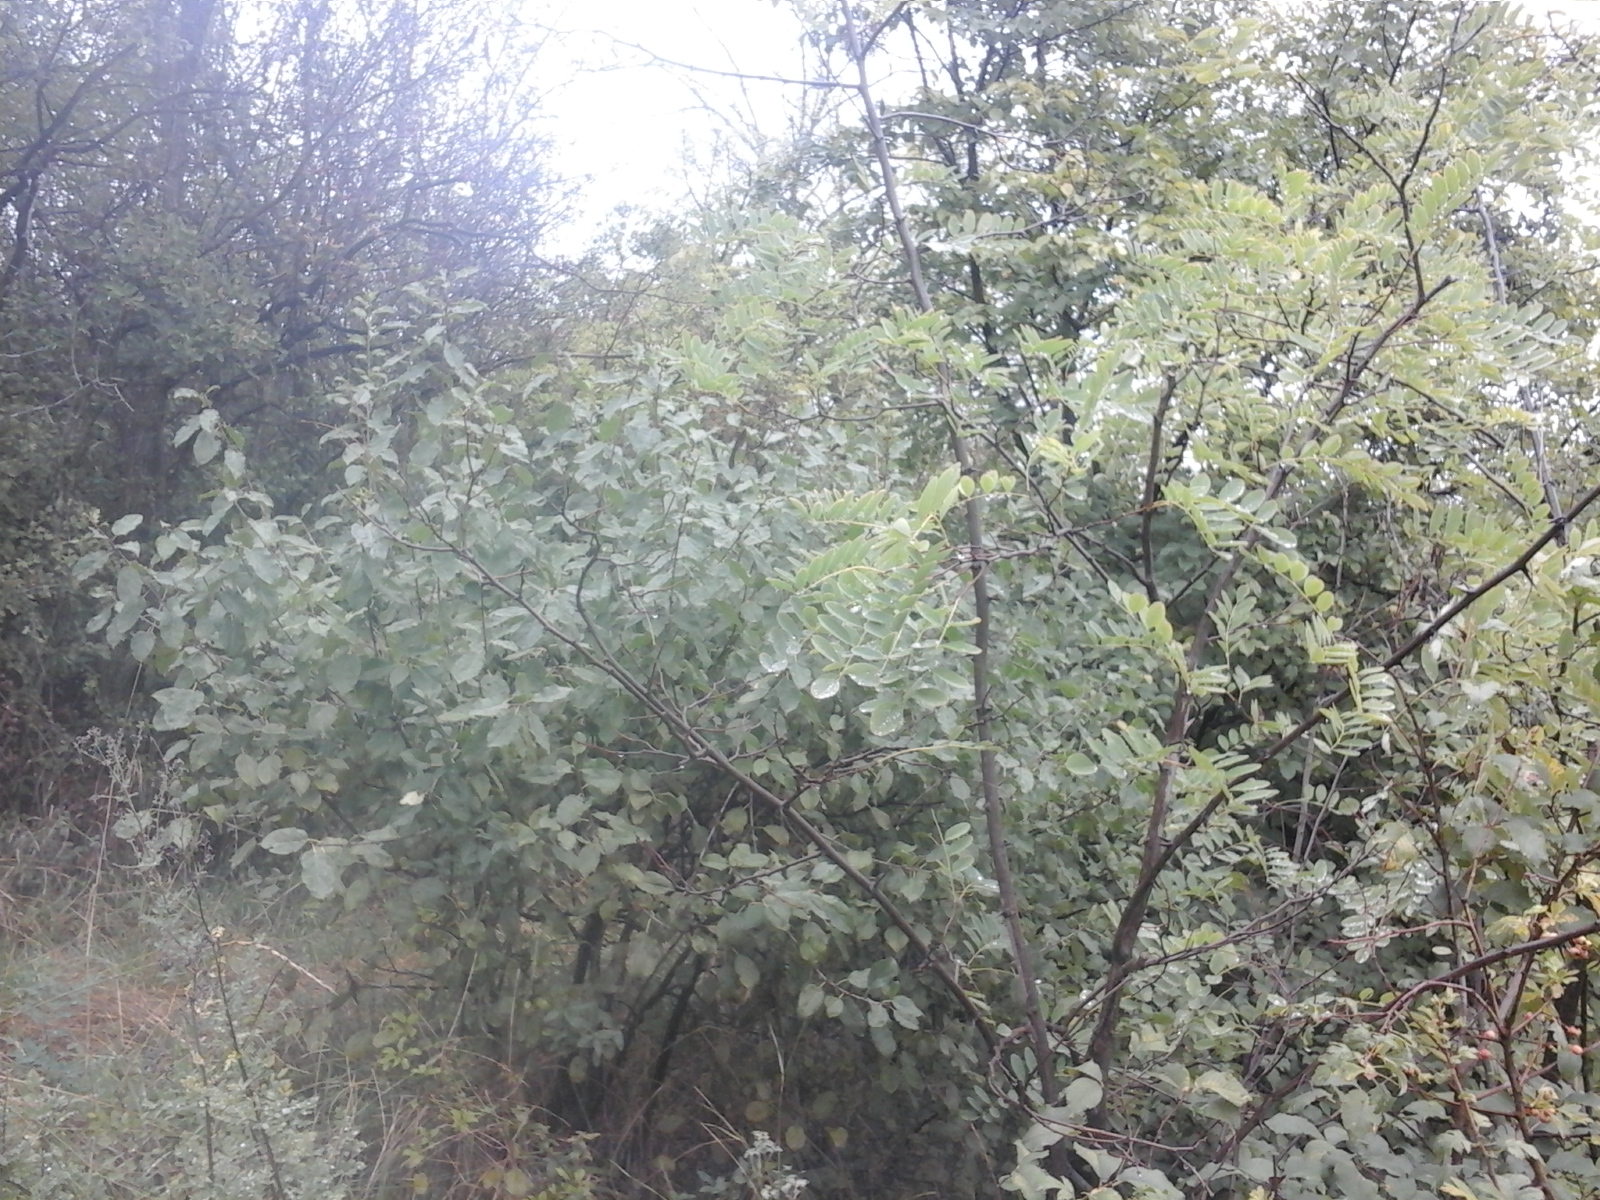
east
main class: Shrubland
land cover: Shrubland with sparse tree cover
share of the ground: > 75 %
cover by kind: shrubs 95 %, broadleaved forest trees 5 %
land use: Fallow land
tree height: < 5 m
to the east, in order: Shrubland with sparse tree cover; Broadleaved woodland; Grassland with sparse tree/shrub cover; Vineyards; Broadleaved woodland; Spontaneously vegetated surfaces
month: September
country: RO
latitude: 47.2636
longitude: 22.5725
